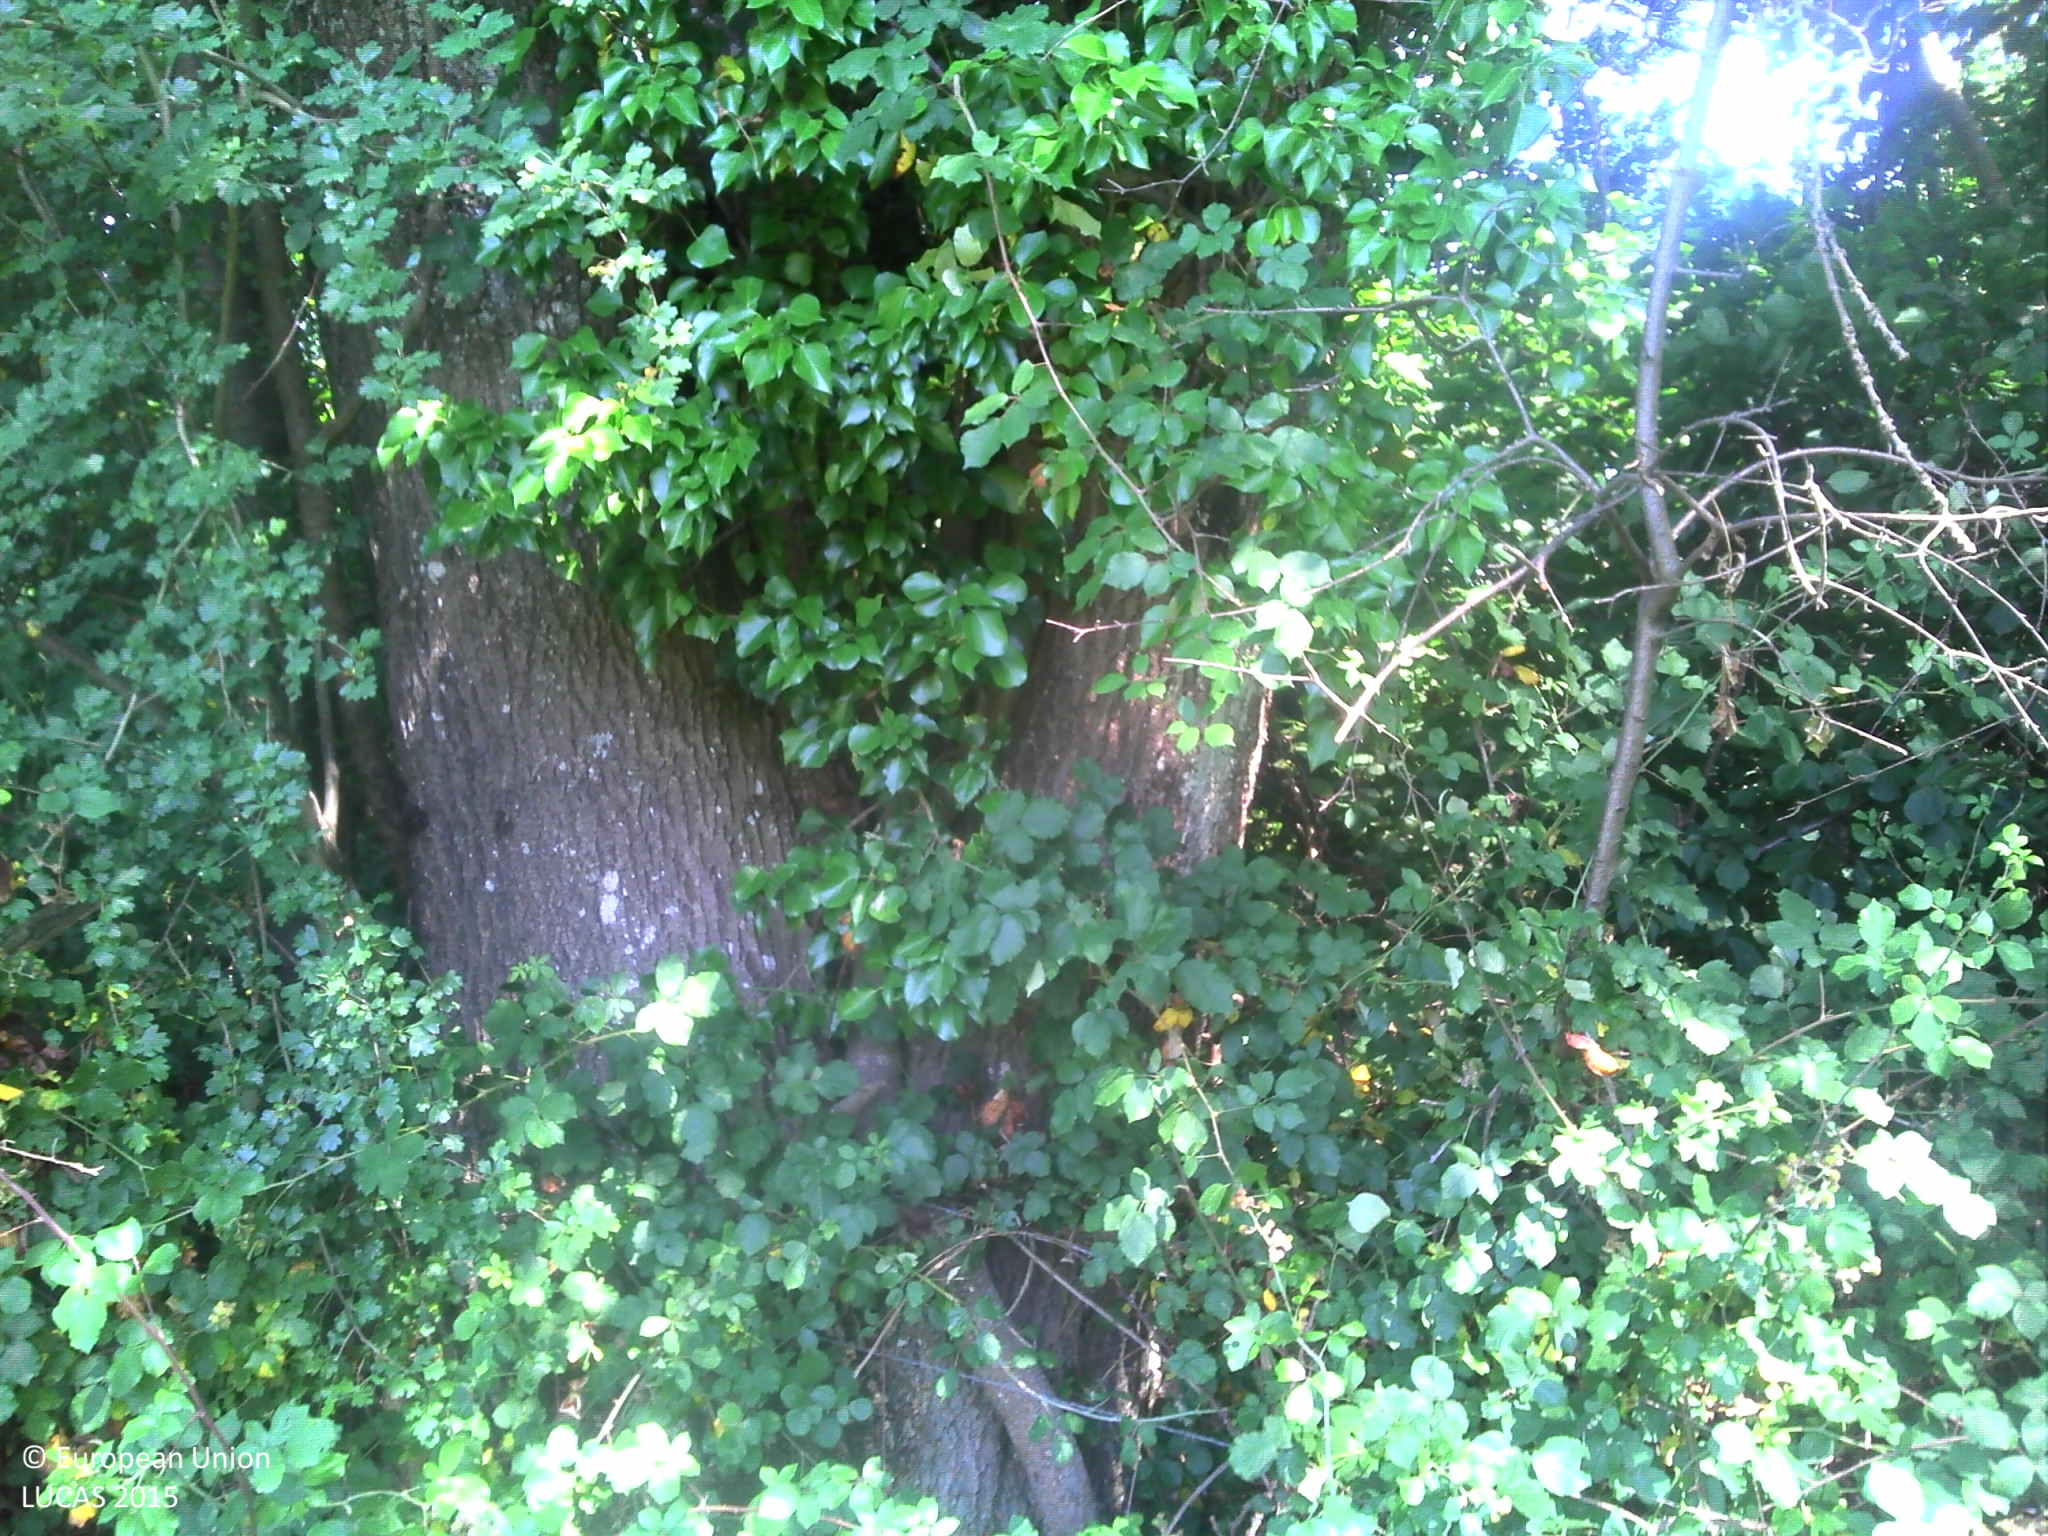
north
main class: Woodland
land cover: Broadleaved woodland
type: mesophytic deciduous forest
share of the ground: > 75 %
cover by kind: broadleaved forest trees 85 %, herbaceous plants 15 %
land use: Forestry
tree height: > 5 m
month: July
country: FR
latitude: 45.6034
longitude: 5.0167
